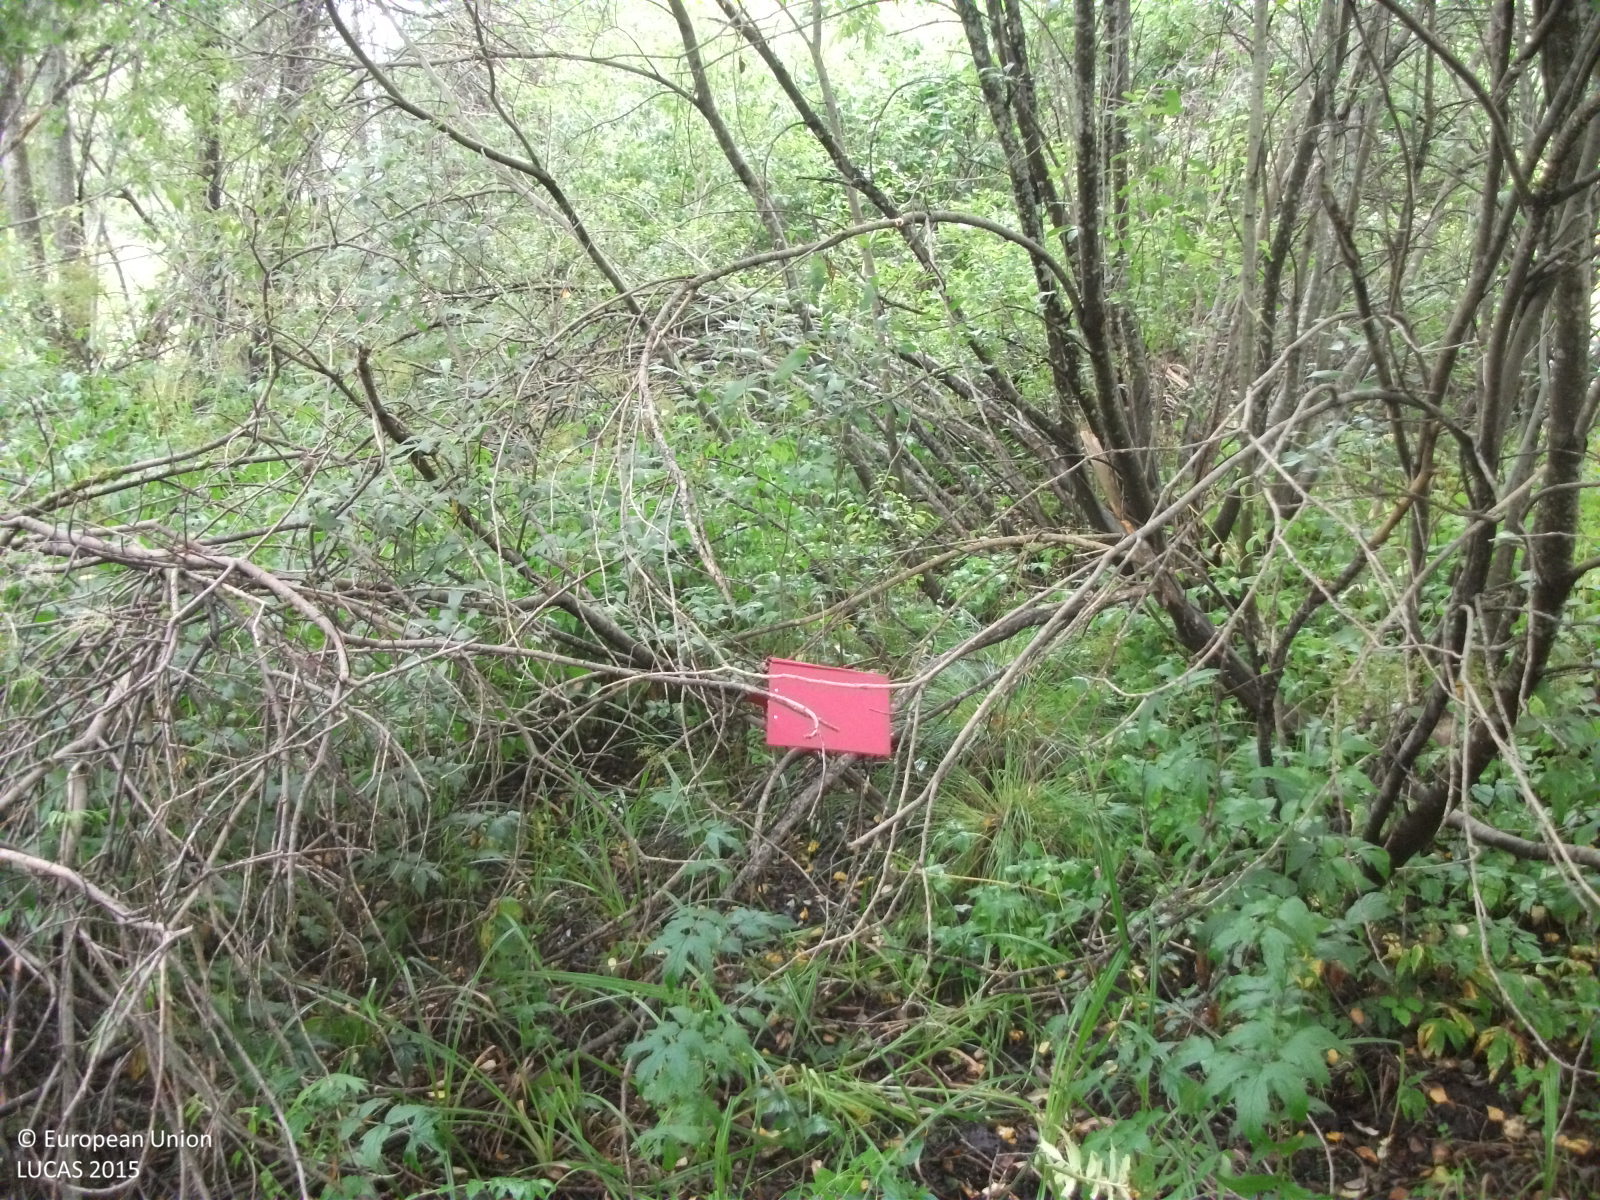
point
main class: Woodland
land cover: Broadleaved woodland
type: non-riverine alder, birch or aspen forest
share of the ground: 50 - 75 %
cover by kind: broadleaved forest trees 60 %, shrubs 25 %, herbaceous plants 15 %
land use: Forestry
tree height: > 5 m
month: September
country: LV
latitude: 57.5735
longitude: 24.8292
